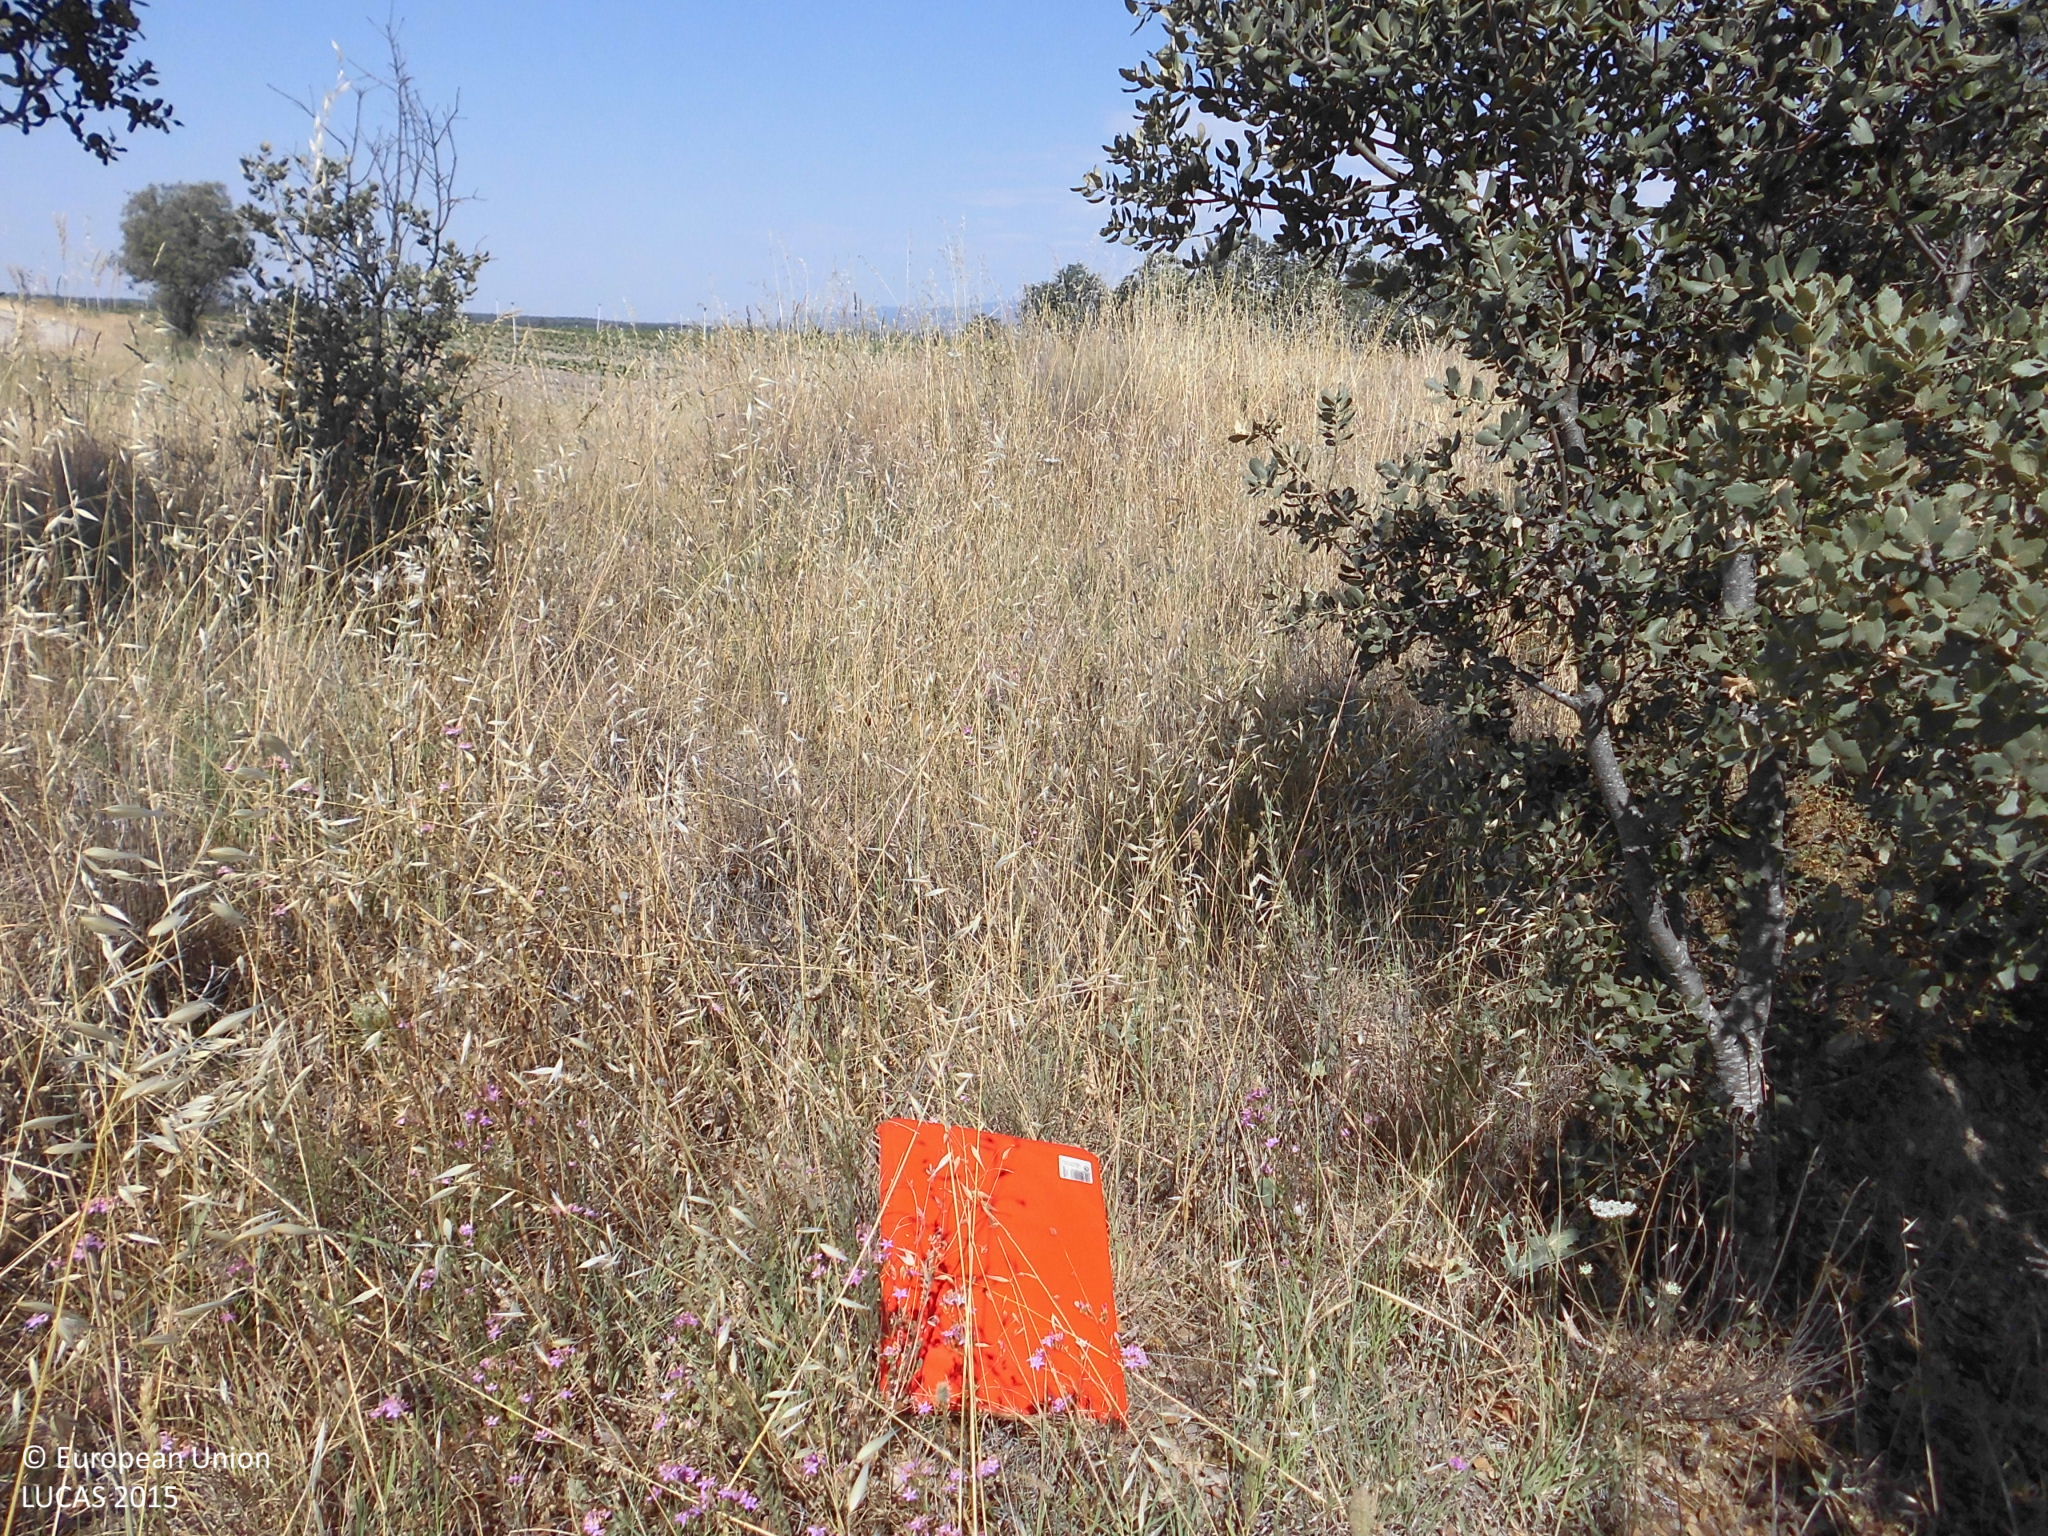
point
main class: Grassland
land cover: Grassland with sparse tree/shrub cover
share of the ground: 25 - 50 %
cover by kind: herbaceous plants 60 %, consolidated bare surface 30 %, broadleaved forest trees 5 %, shrubs 5 %
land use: Abandoned areas
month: June
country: ES
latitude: 40.0249
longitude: -5.4681
